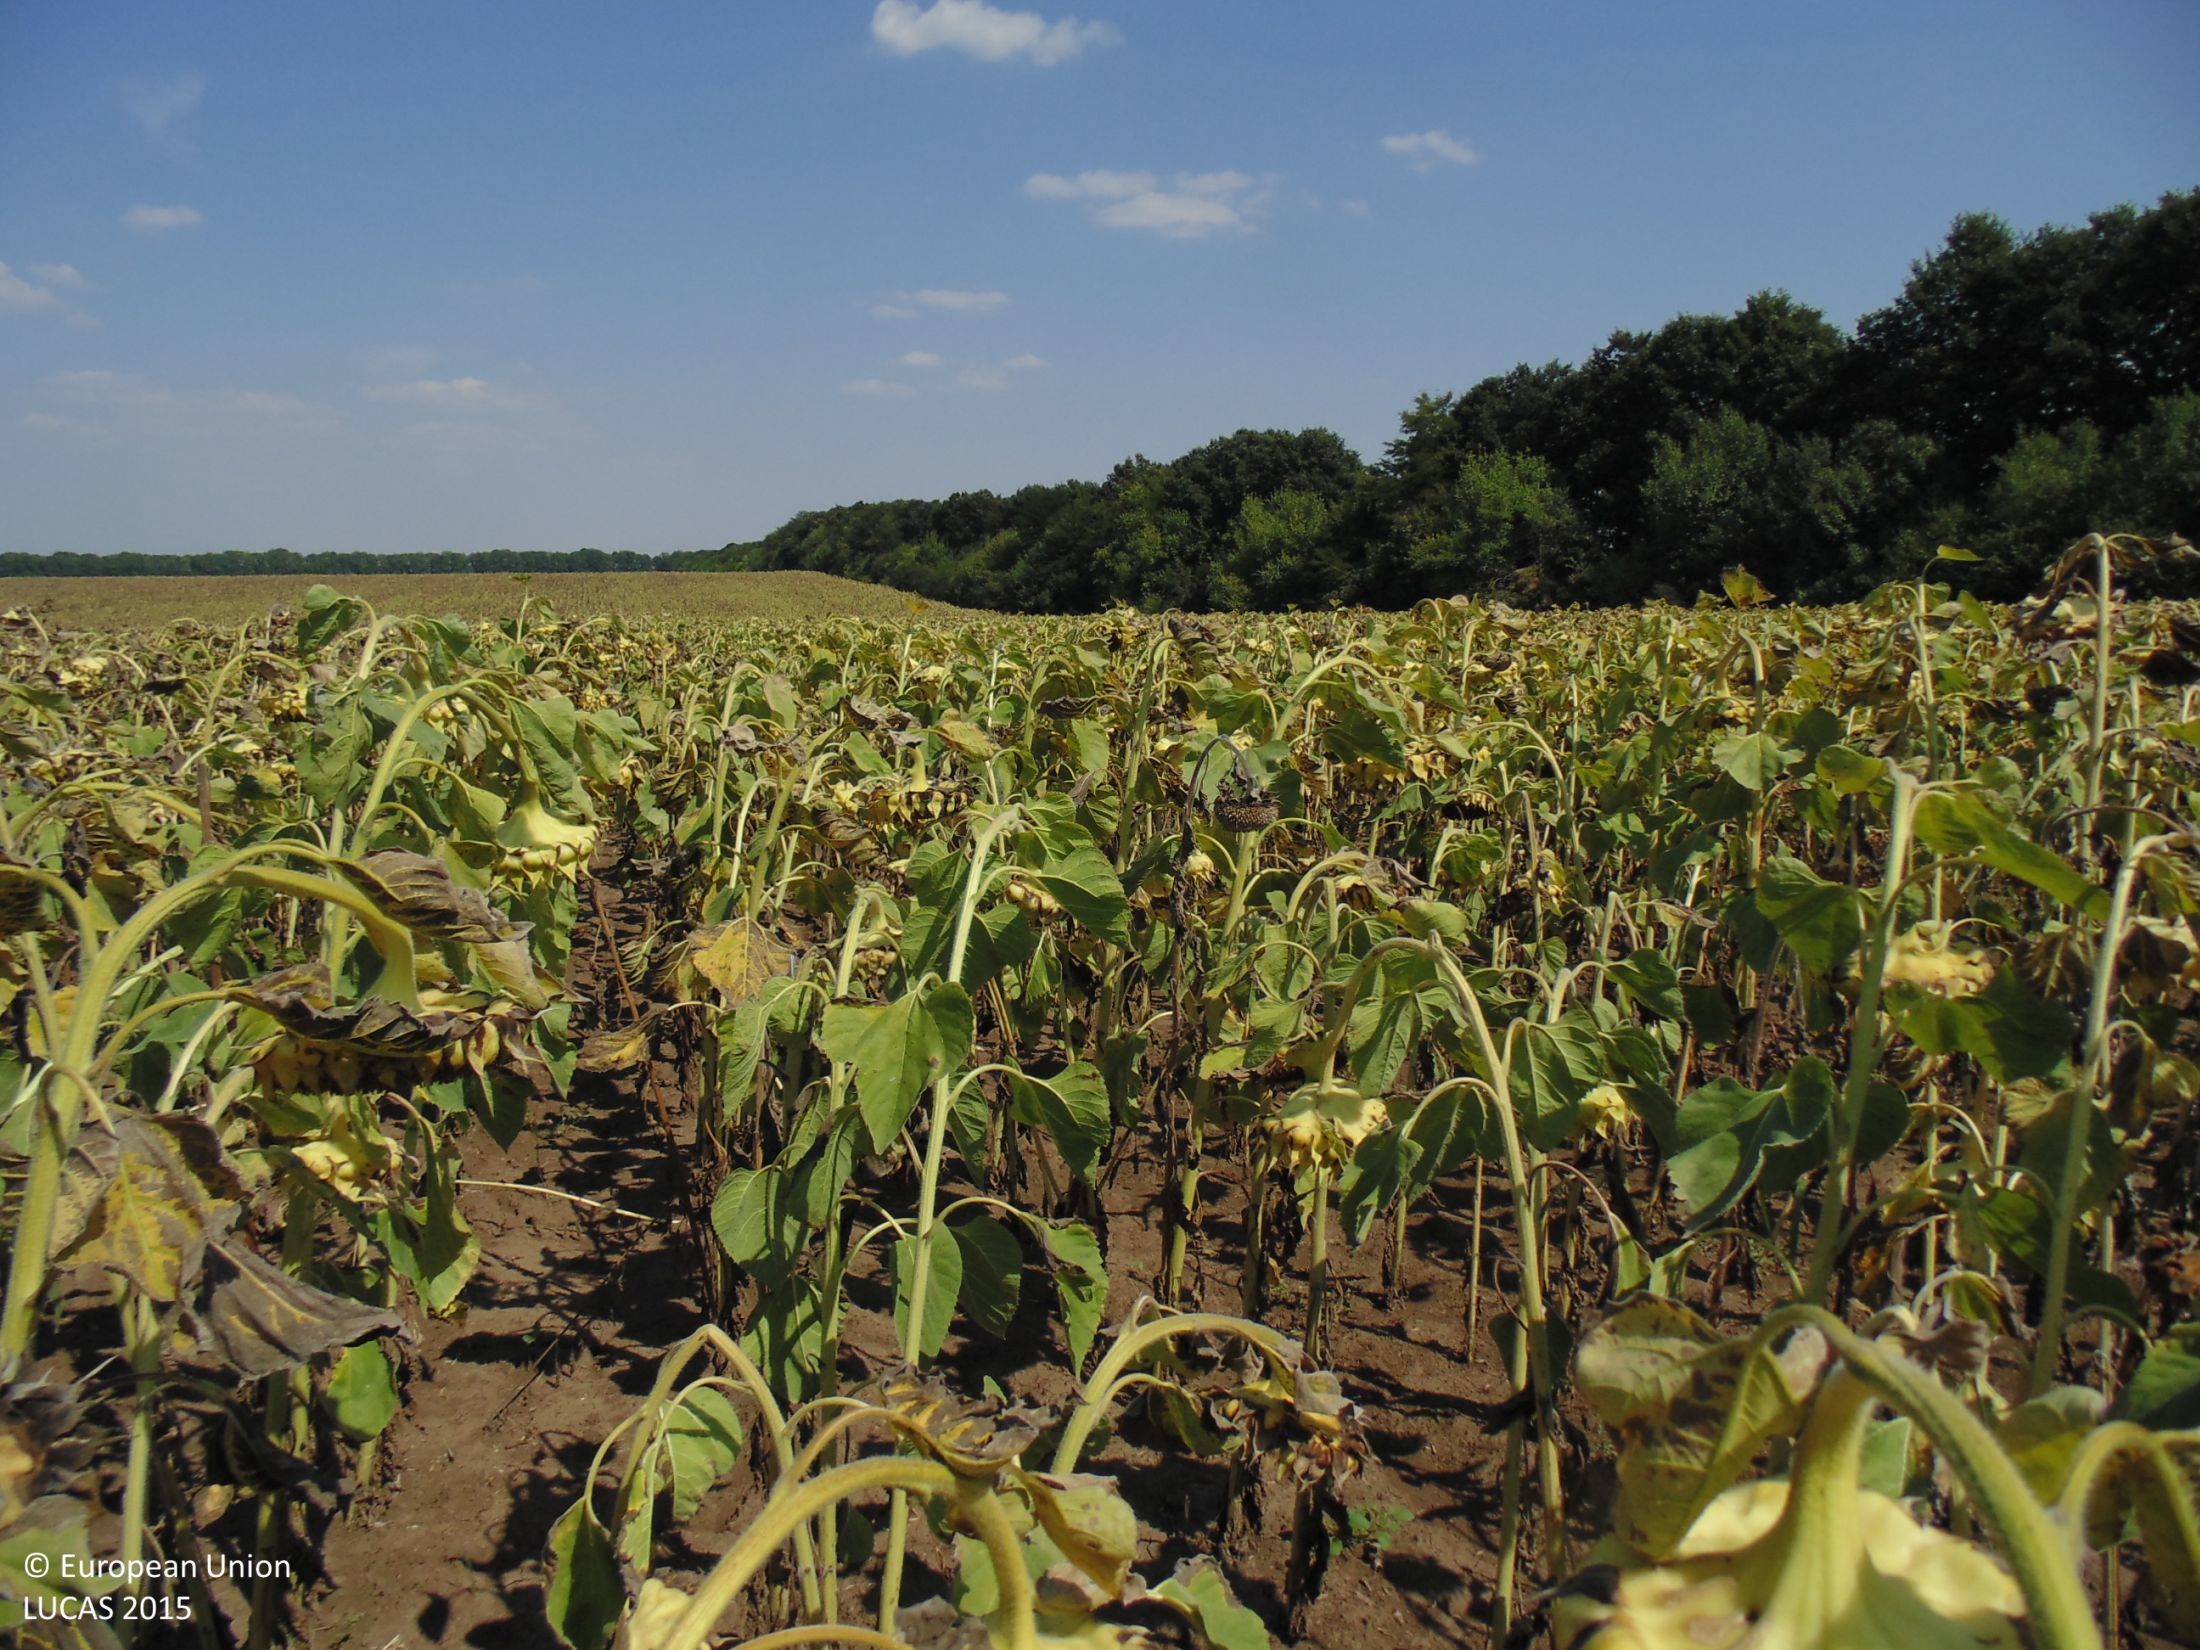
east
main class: Cropland
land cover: Sunflower
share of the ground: > 75 %
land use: Agriculture (excluding fallow land and kitchen gardens)
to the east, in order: Sunflower
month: August
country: BG
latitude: 43.7547
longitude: 27.4842
